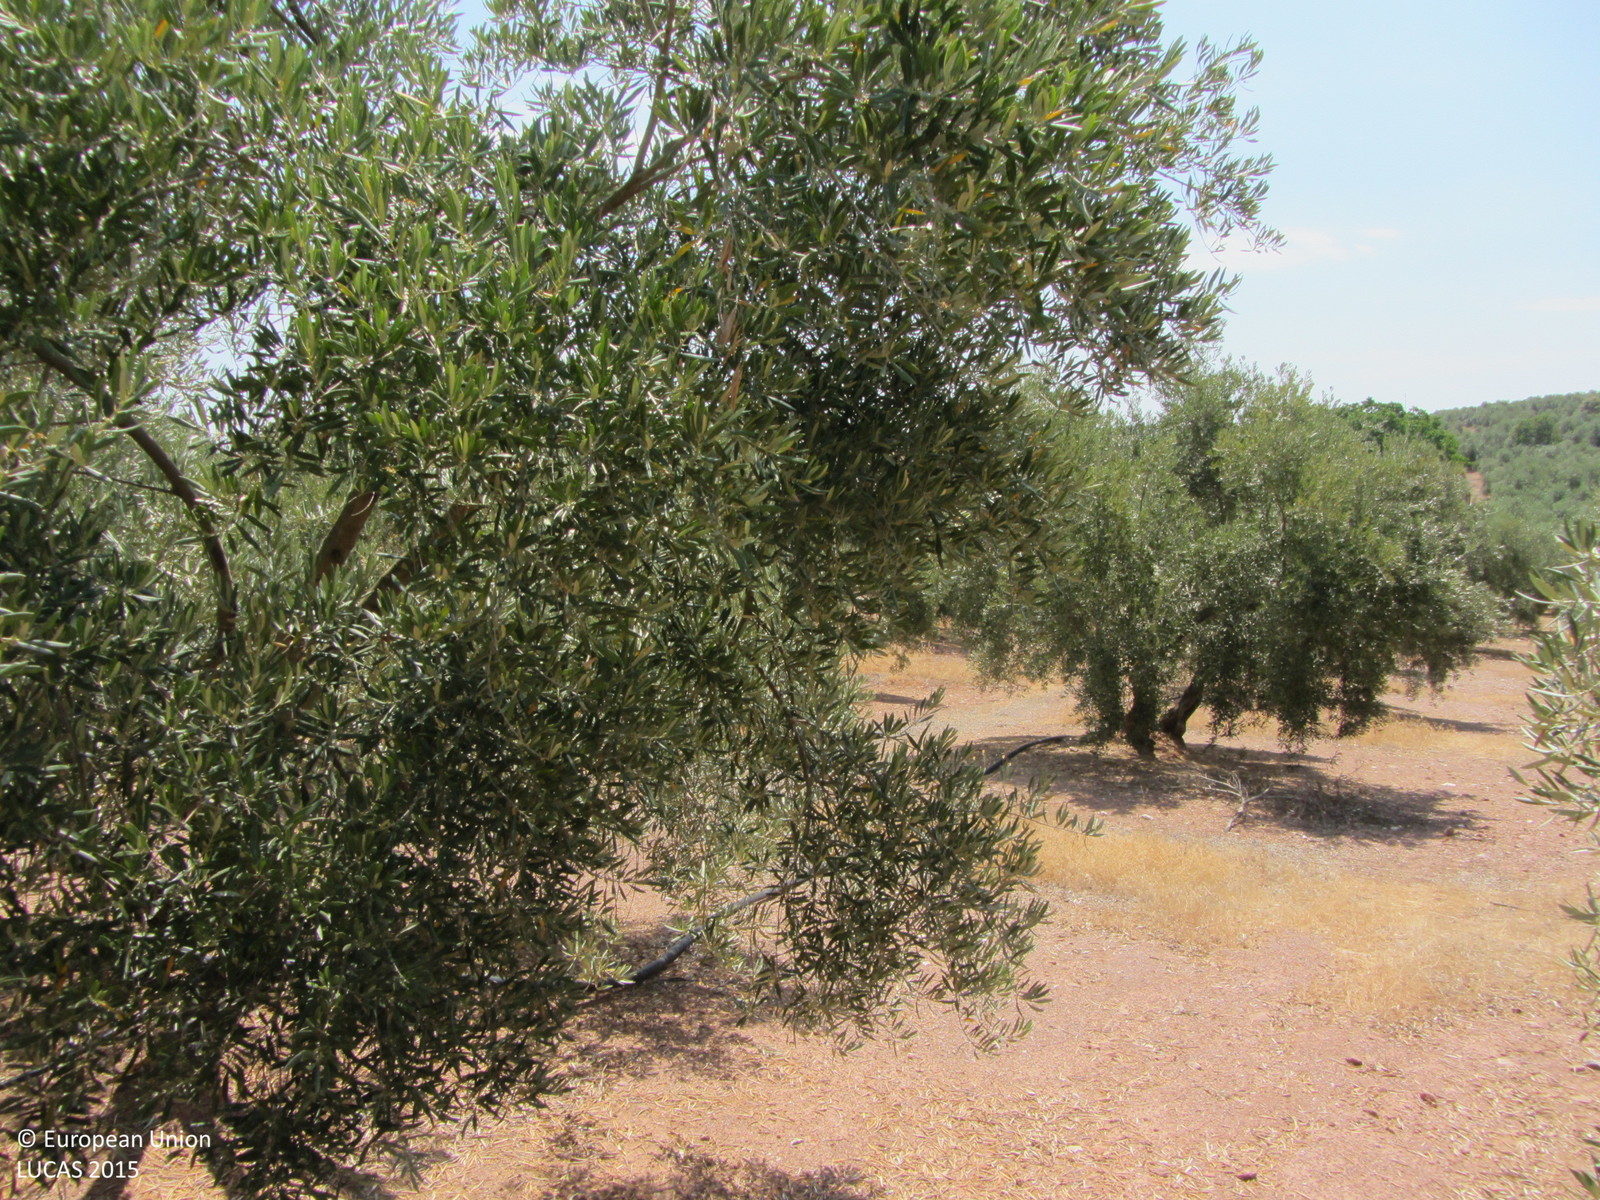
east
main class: Cropland
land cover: Olive groves
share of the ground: 25 - 50 %
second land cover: Other bare soil
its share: > 75 %
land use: Agriculture (excluding fallow land and kitchen gardens)
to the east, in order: Olive groves; Other bare soil; Tracks; Grass margins; Fences; Grassland without tree/shrub cover; Grassland with sparse tree/shrub cover
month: June
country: ES
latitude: 38.2221
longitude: -3.4251
